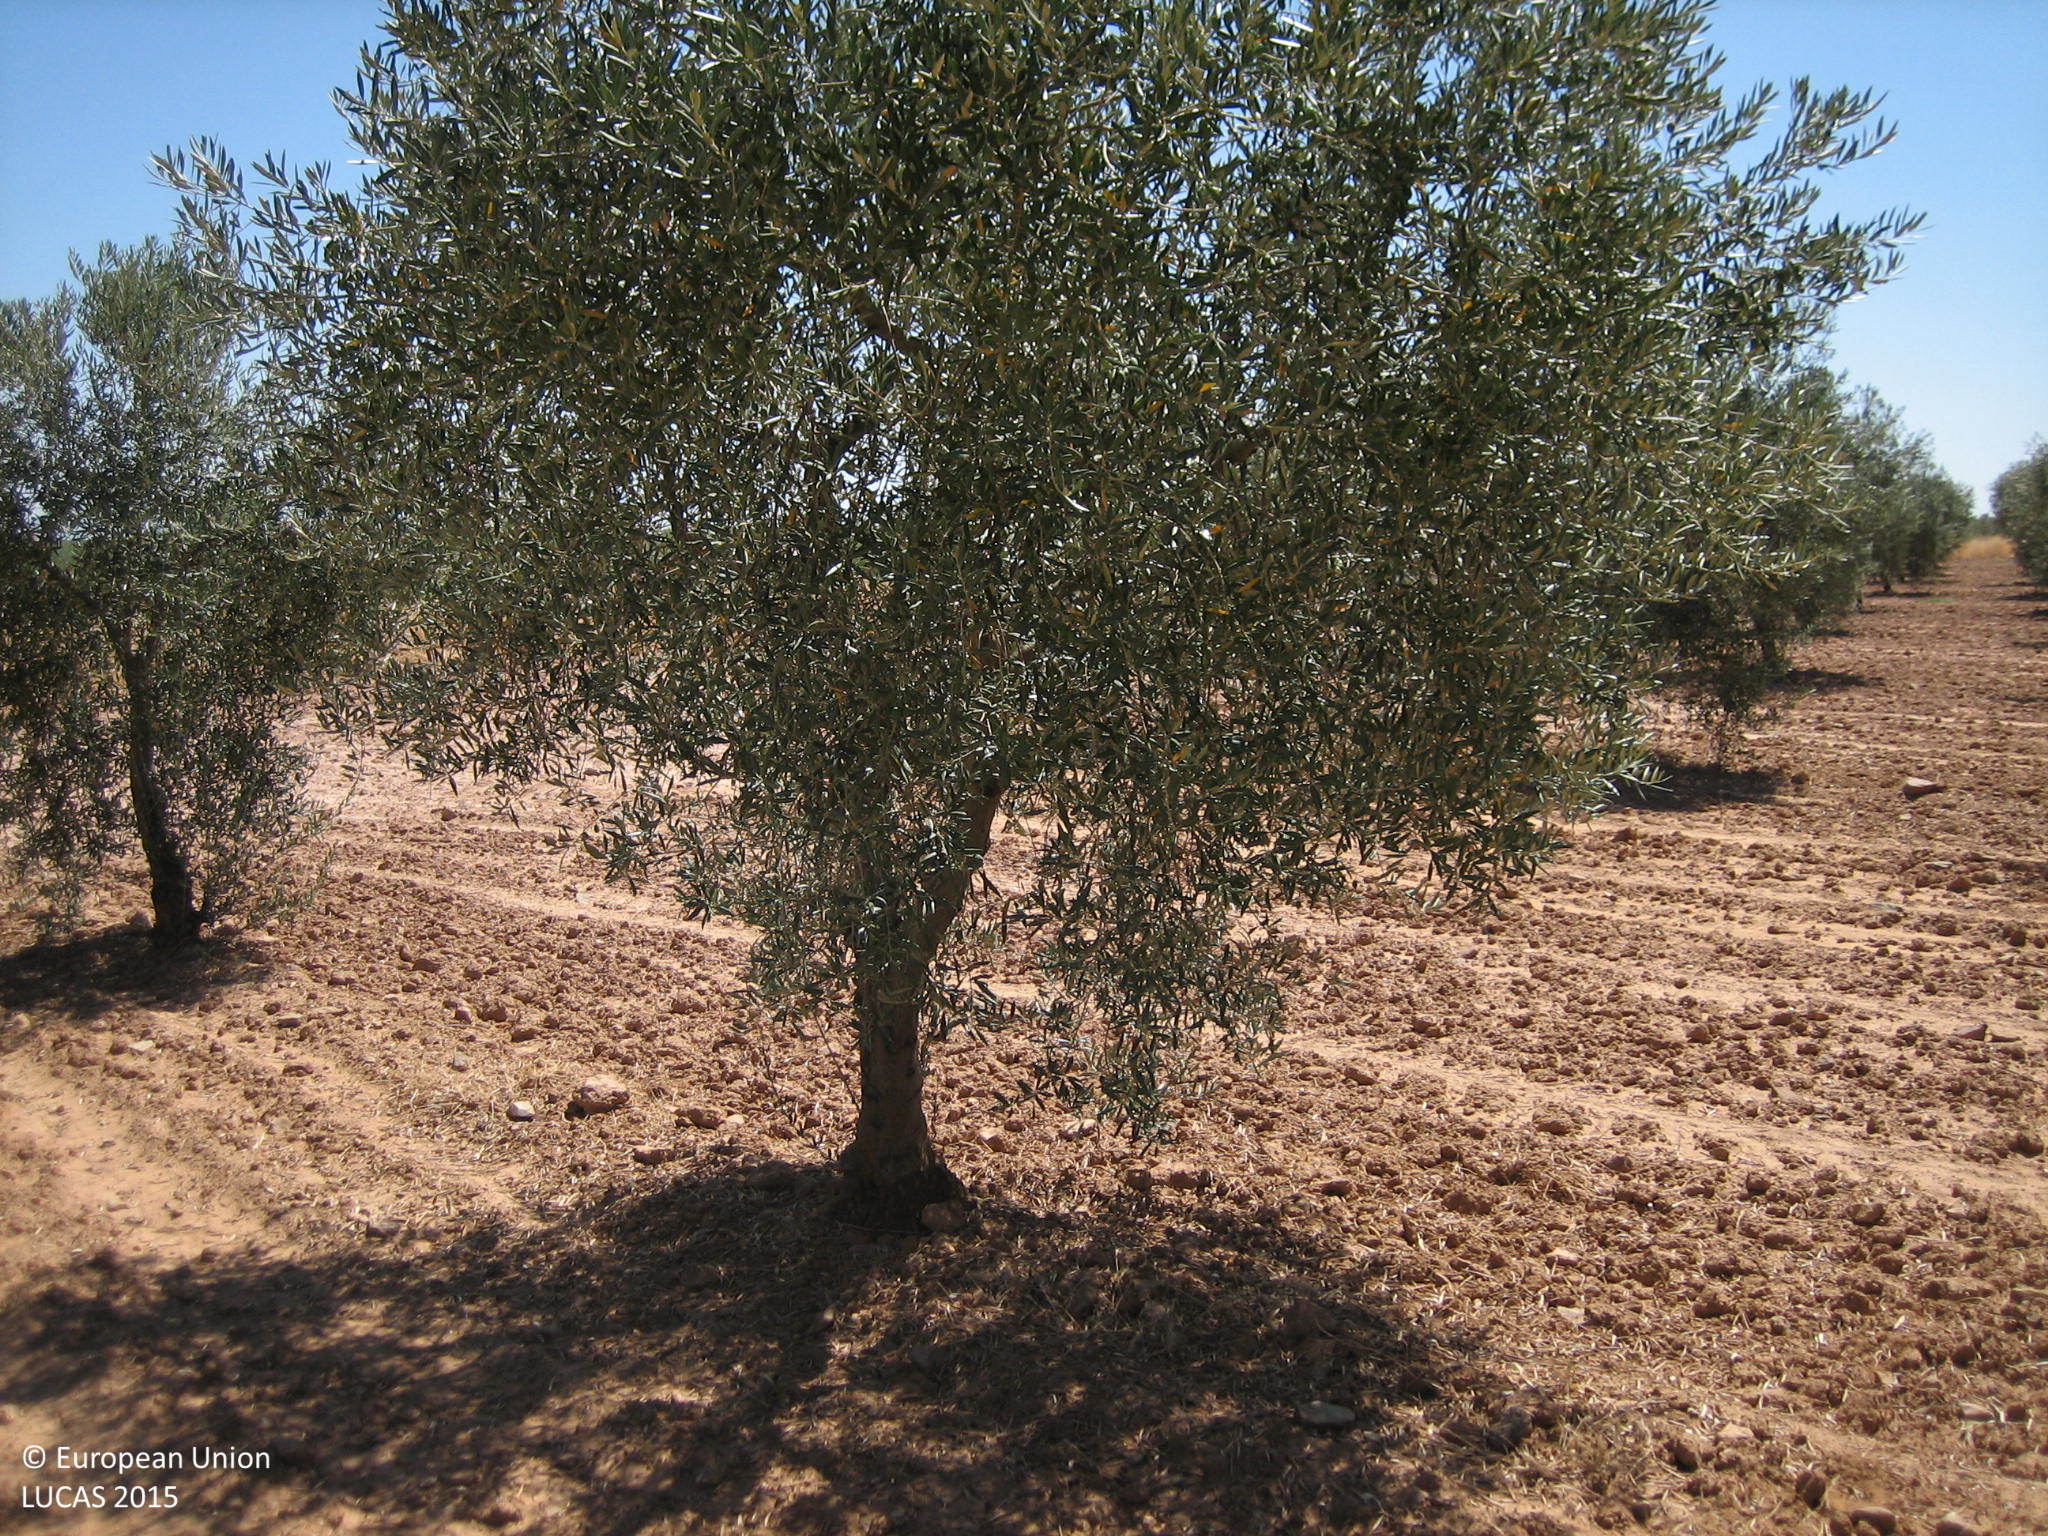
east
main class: Cropland
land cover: Olive groves
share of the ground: 25 - 50 %
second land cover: Other bare soil
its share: > 75 %
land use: Agriculture (excluding fallow land and kitchen gardens)
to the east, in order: Olive groves; Other bare soil; Dry stone walls; Tracks; Dry stone walls; Olive groves
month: July
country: ES
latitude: 38.4287
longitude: -6.3264
